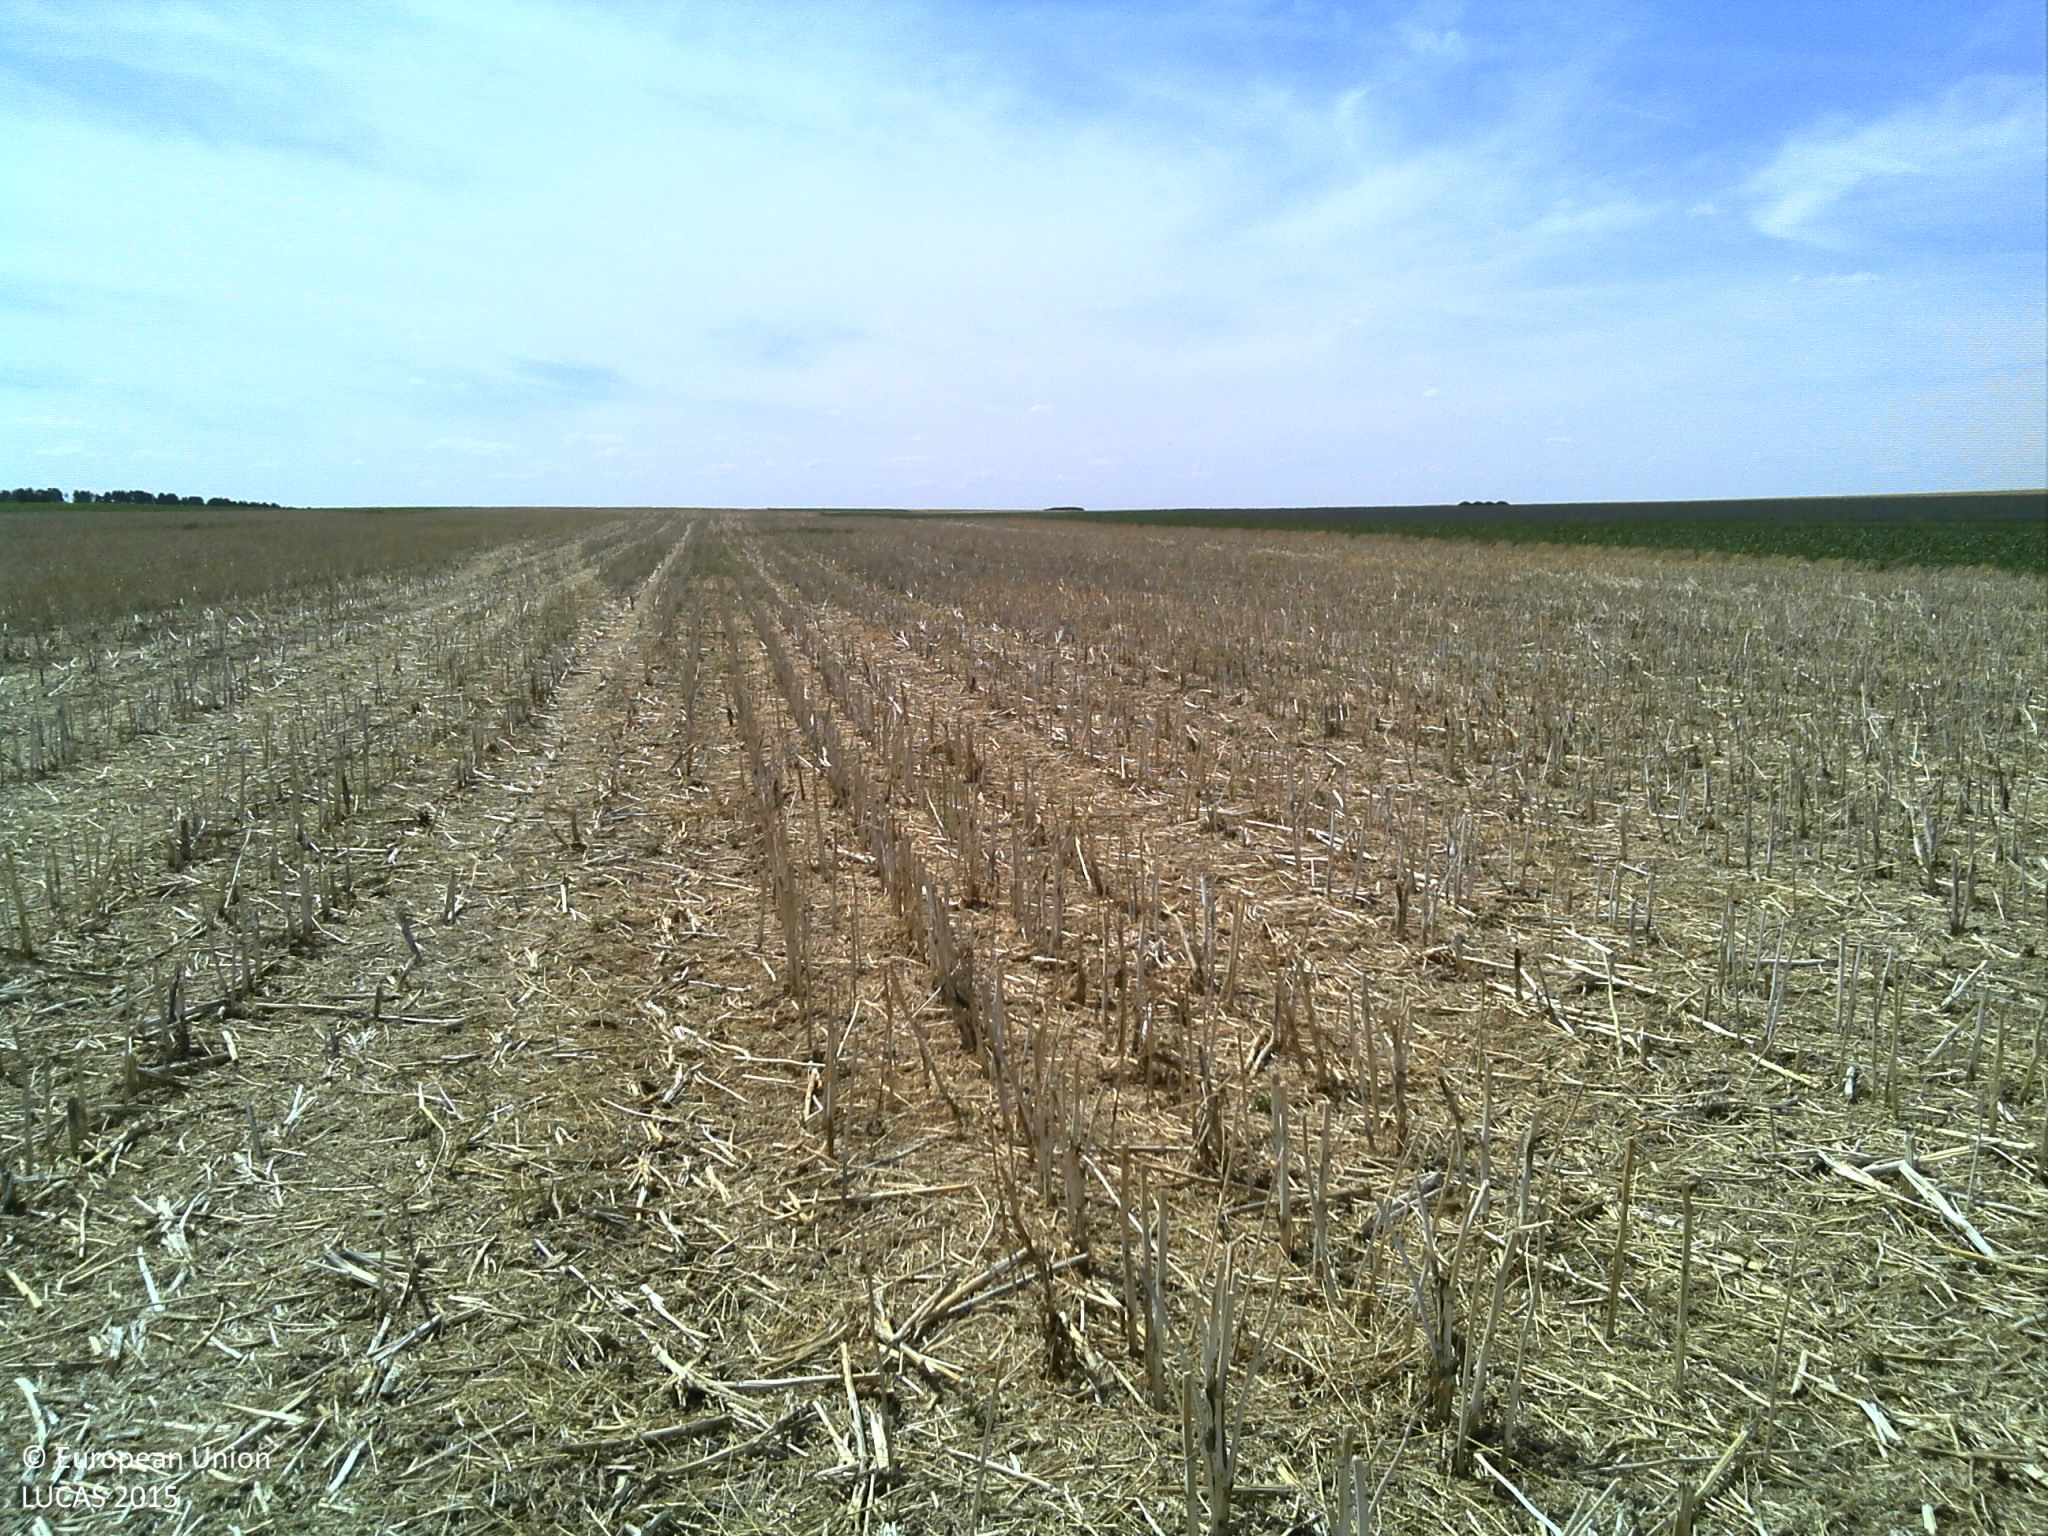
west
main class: Cropland
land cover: Rape and turnip rape
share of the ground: > 75 %
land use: Agriculture (excluding fallow land and kitchen gardens)
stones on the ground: < 10 %
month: August
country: FR
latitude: 48.9967
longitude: 4.6803
